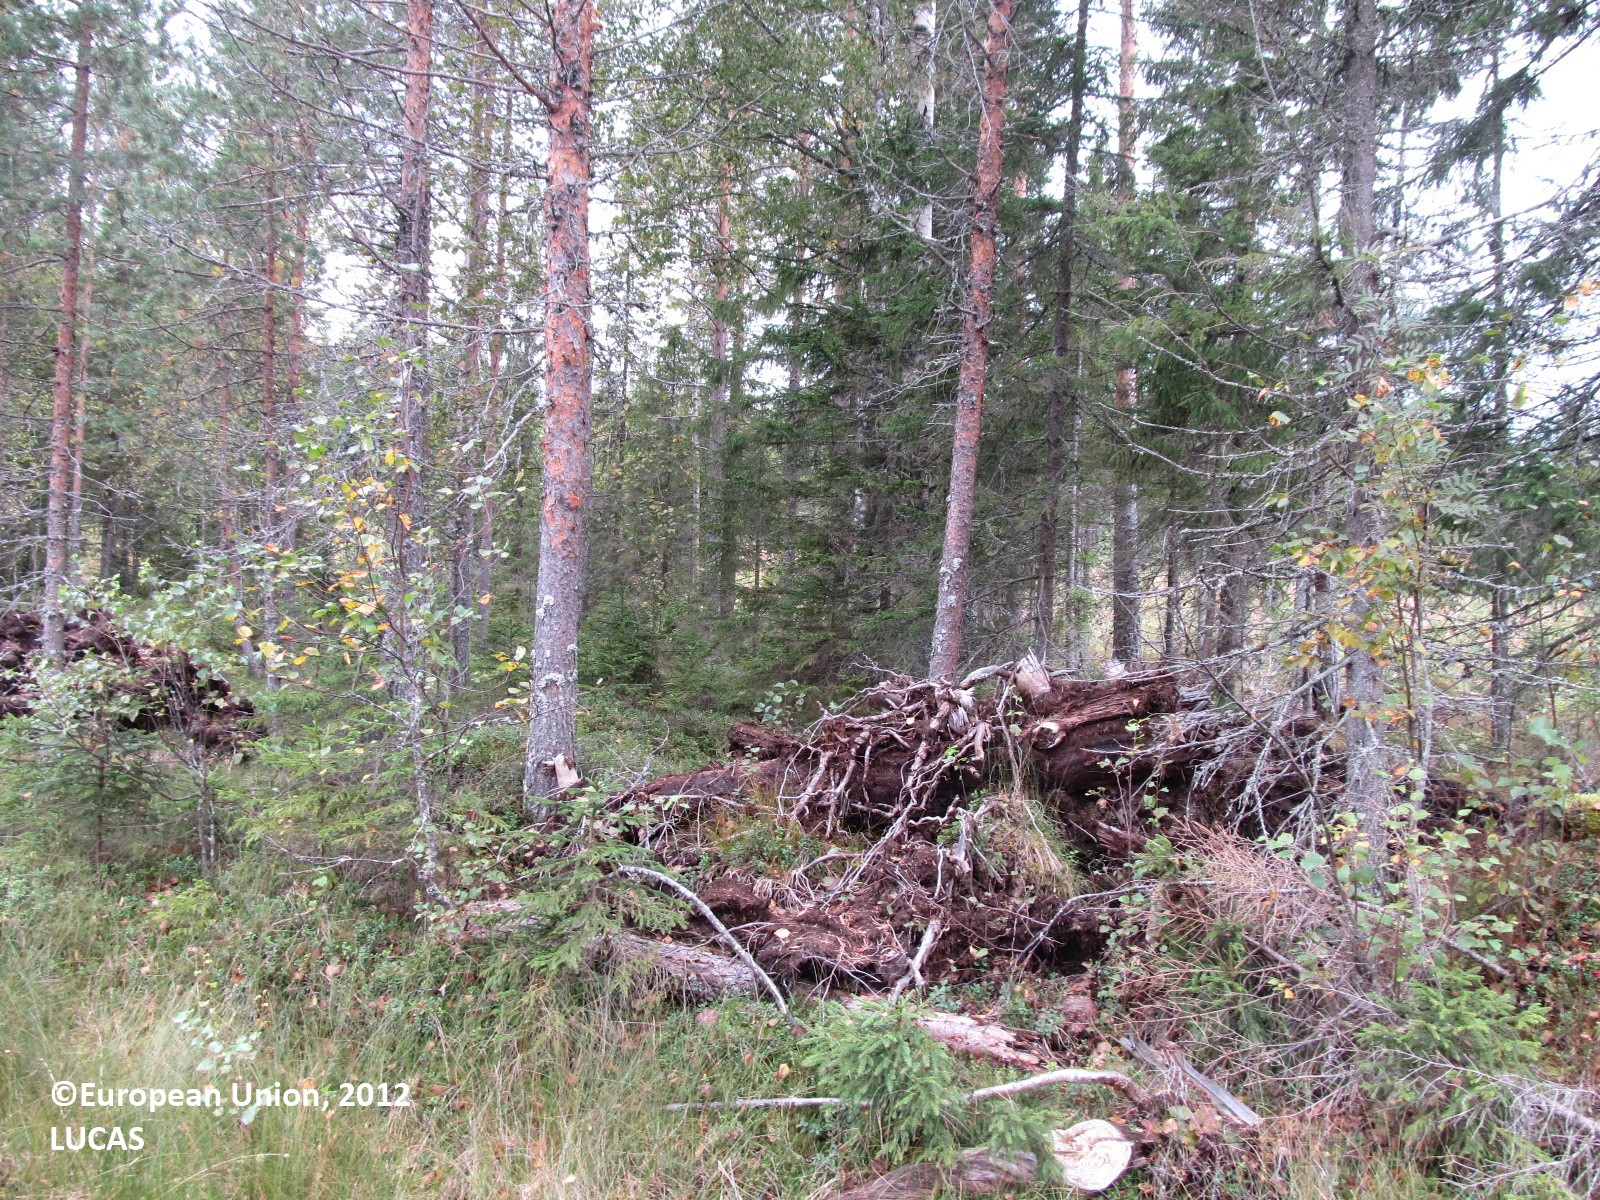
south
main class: Woodland
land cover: Pine dominated coniferous woodland
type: boreal forest
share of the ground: 25 - 50 %
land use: Forestry
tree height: > 5 m
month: September
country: FI
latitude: 63.0653
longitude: 28.5394
